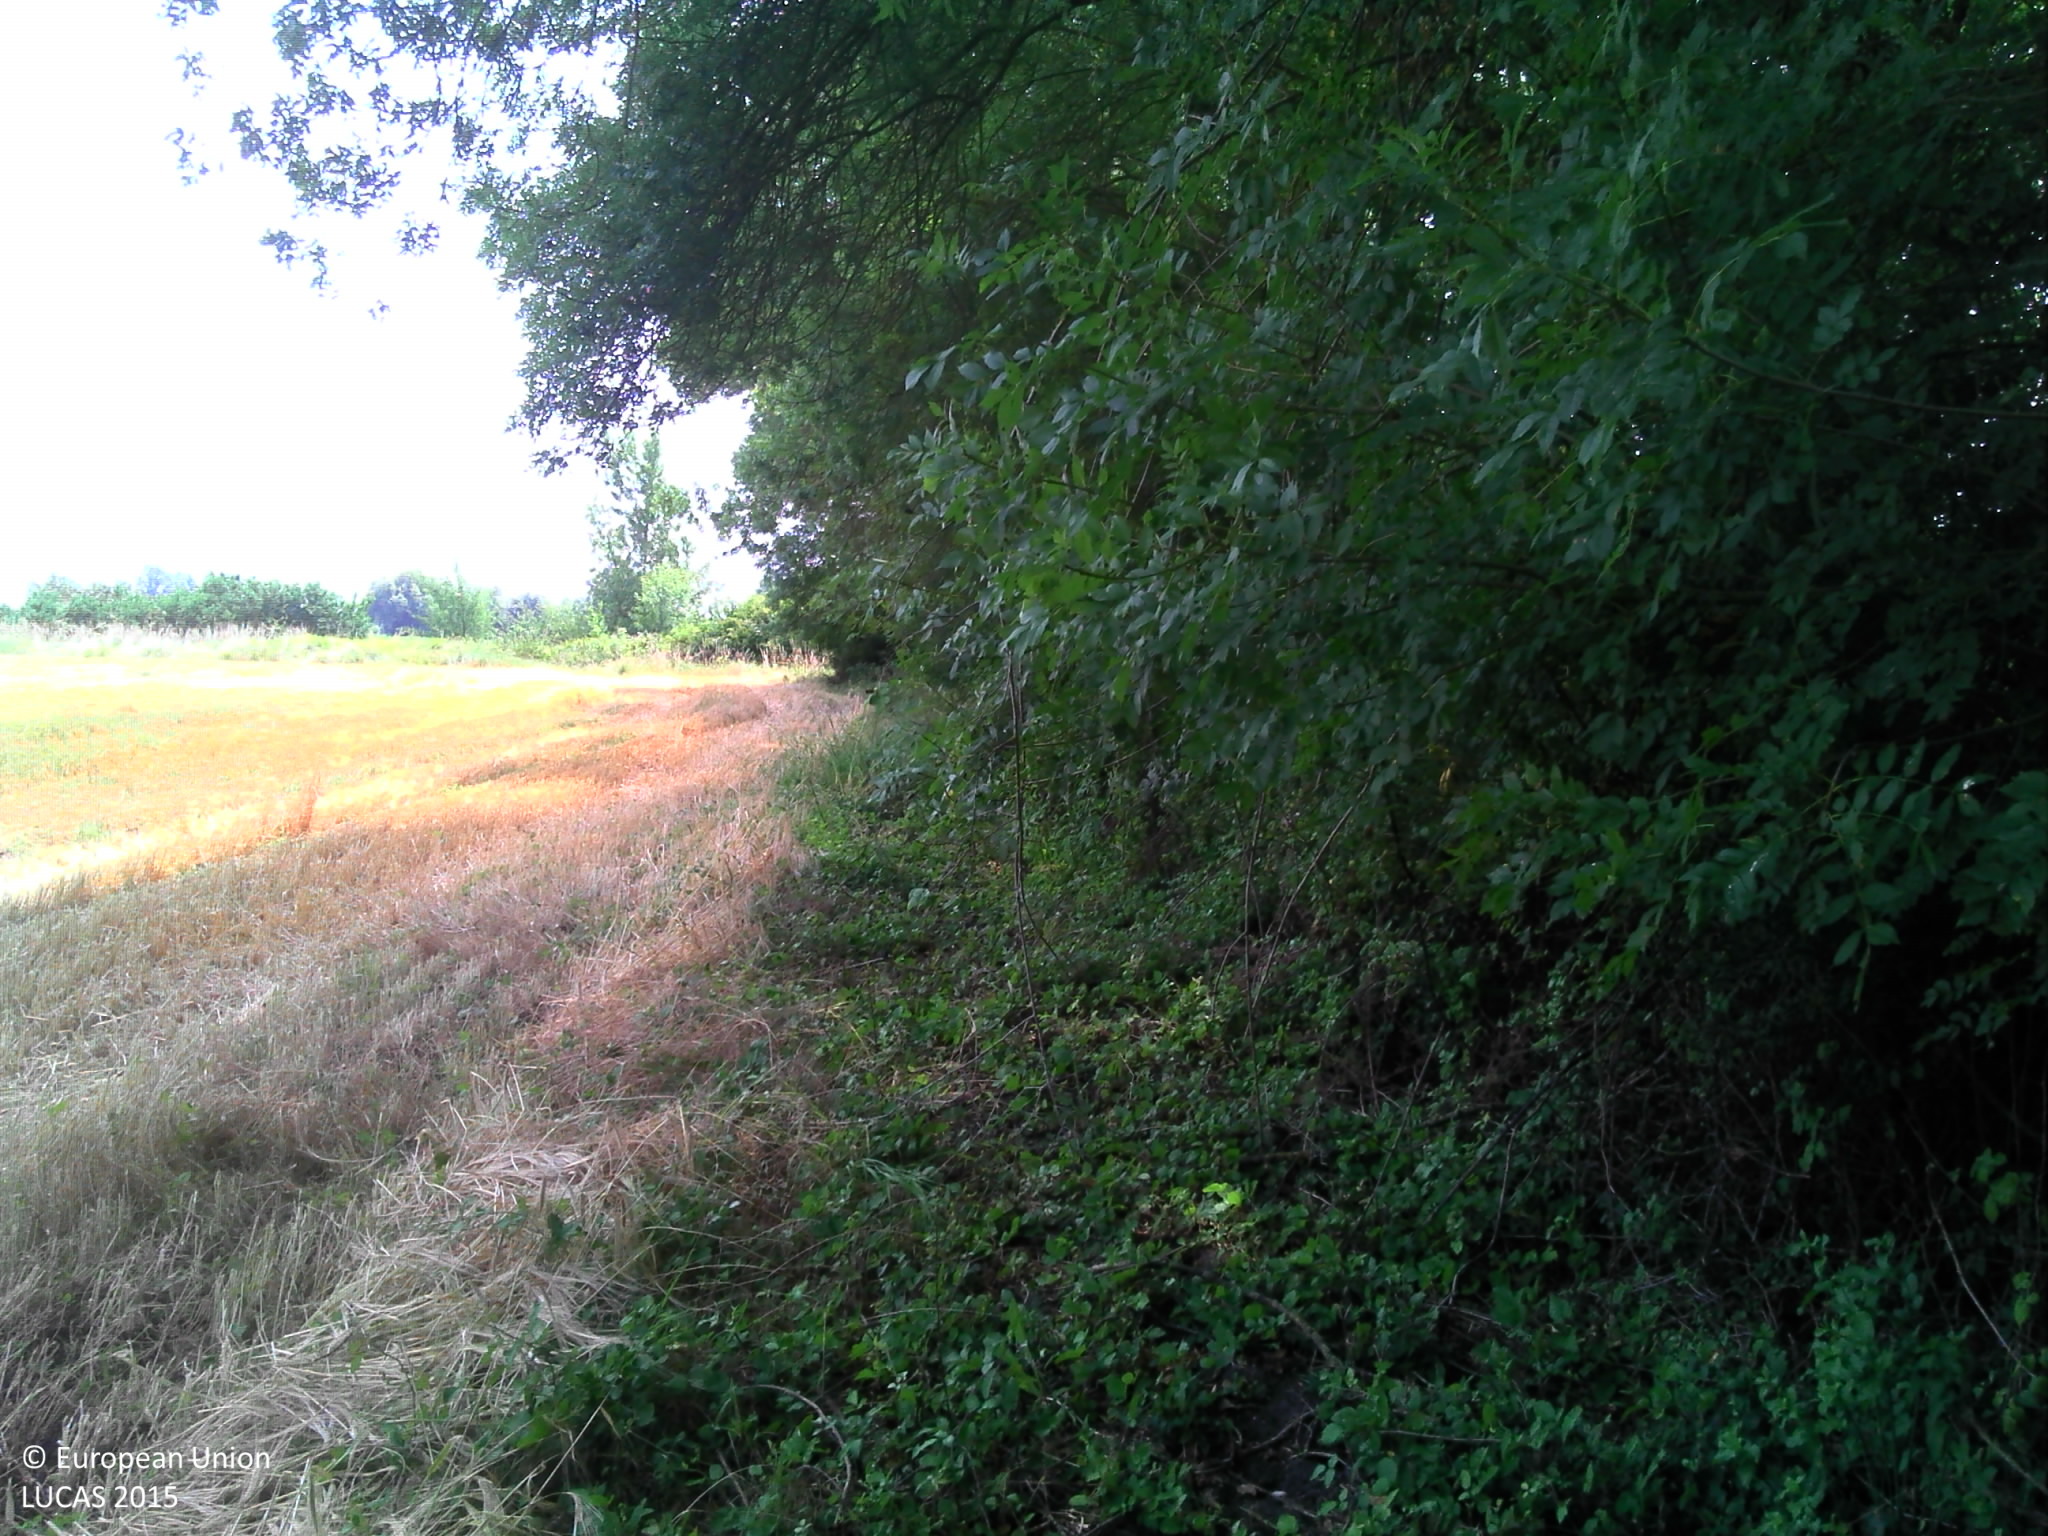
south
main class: Woodland
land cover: Broadleaved woodland
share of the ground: > 75 %
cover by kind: broadleaved forest trees 65 %, shrubs 35 %
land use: Forestry
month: July
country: FR
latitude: 47.2742
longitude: 0.1548
